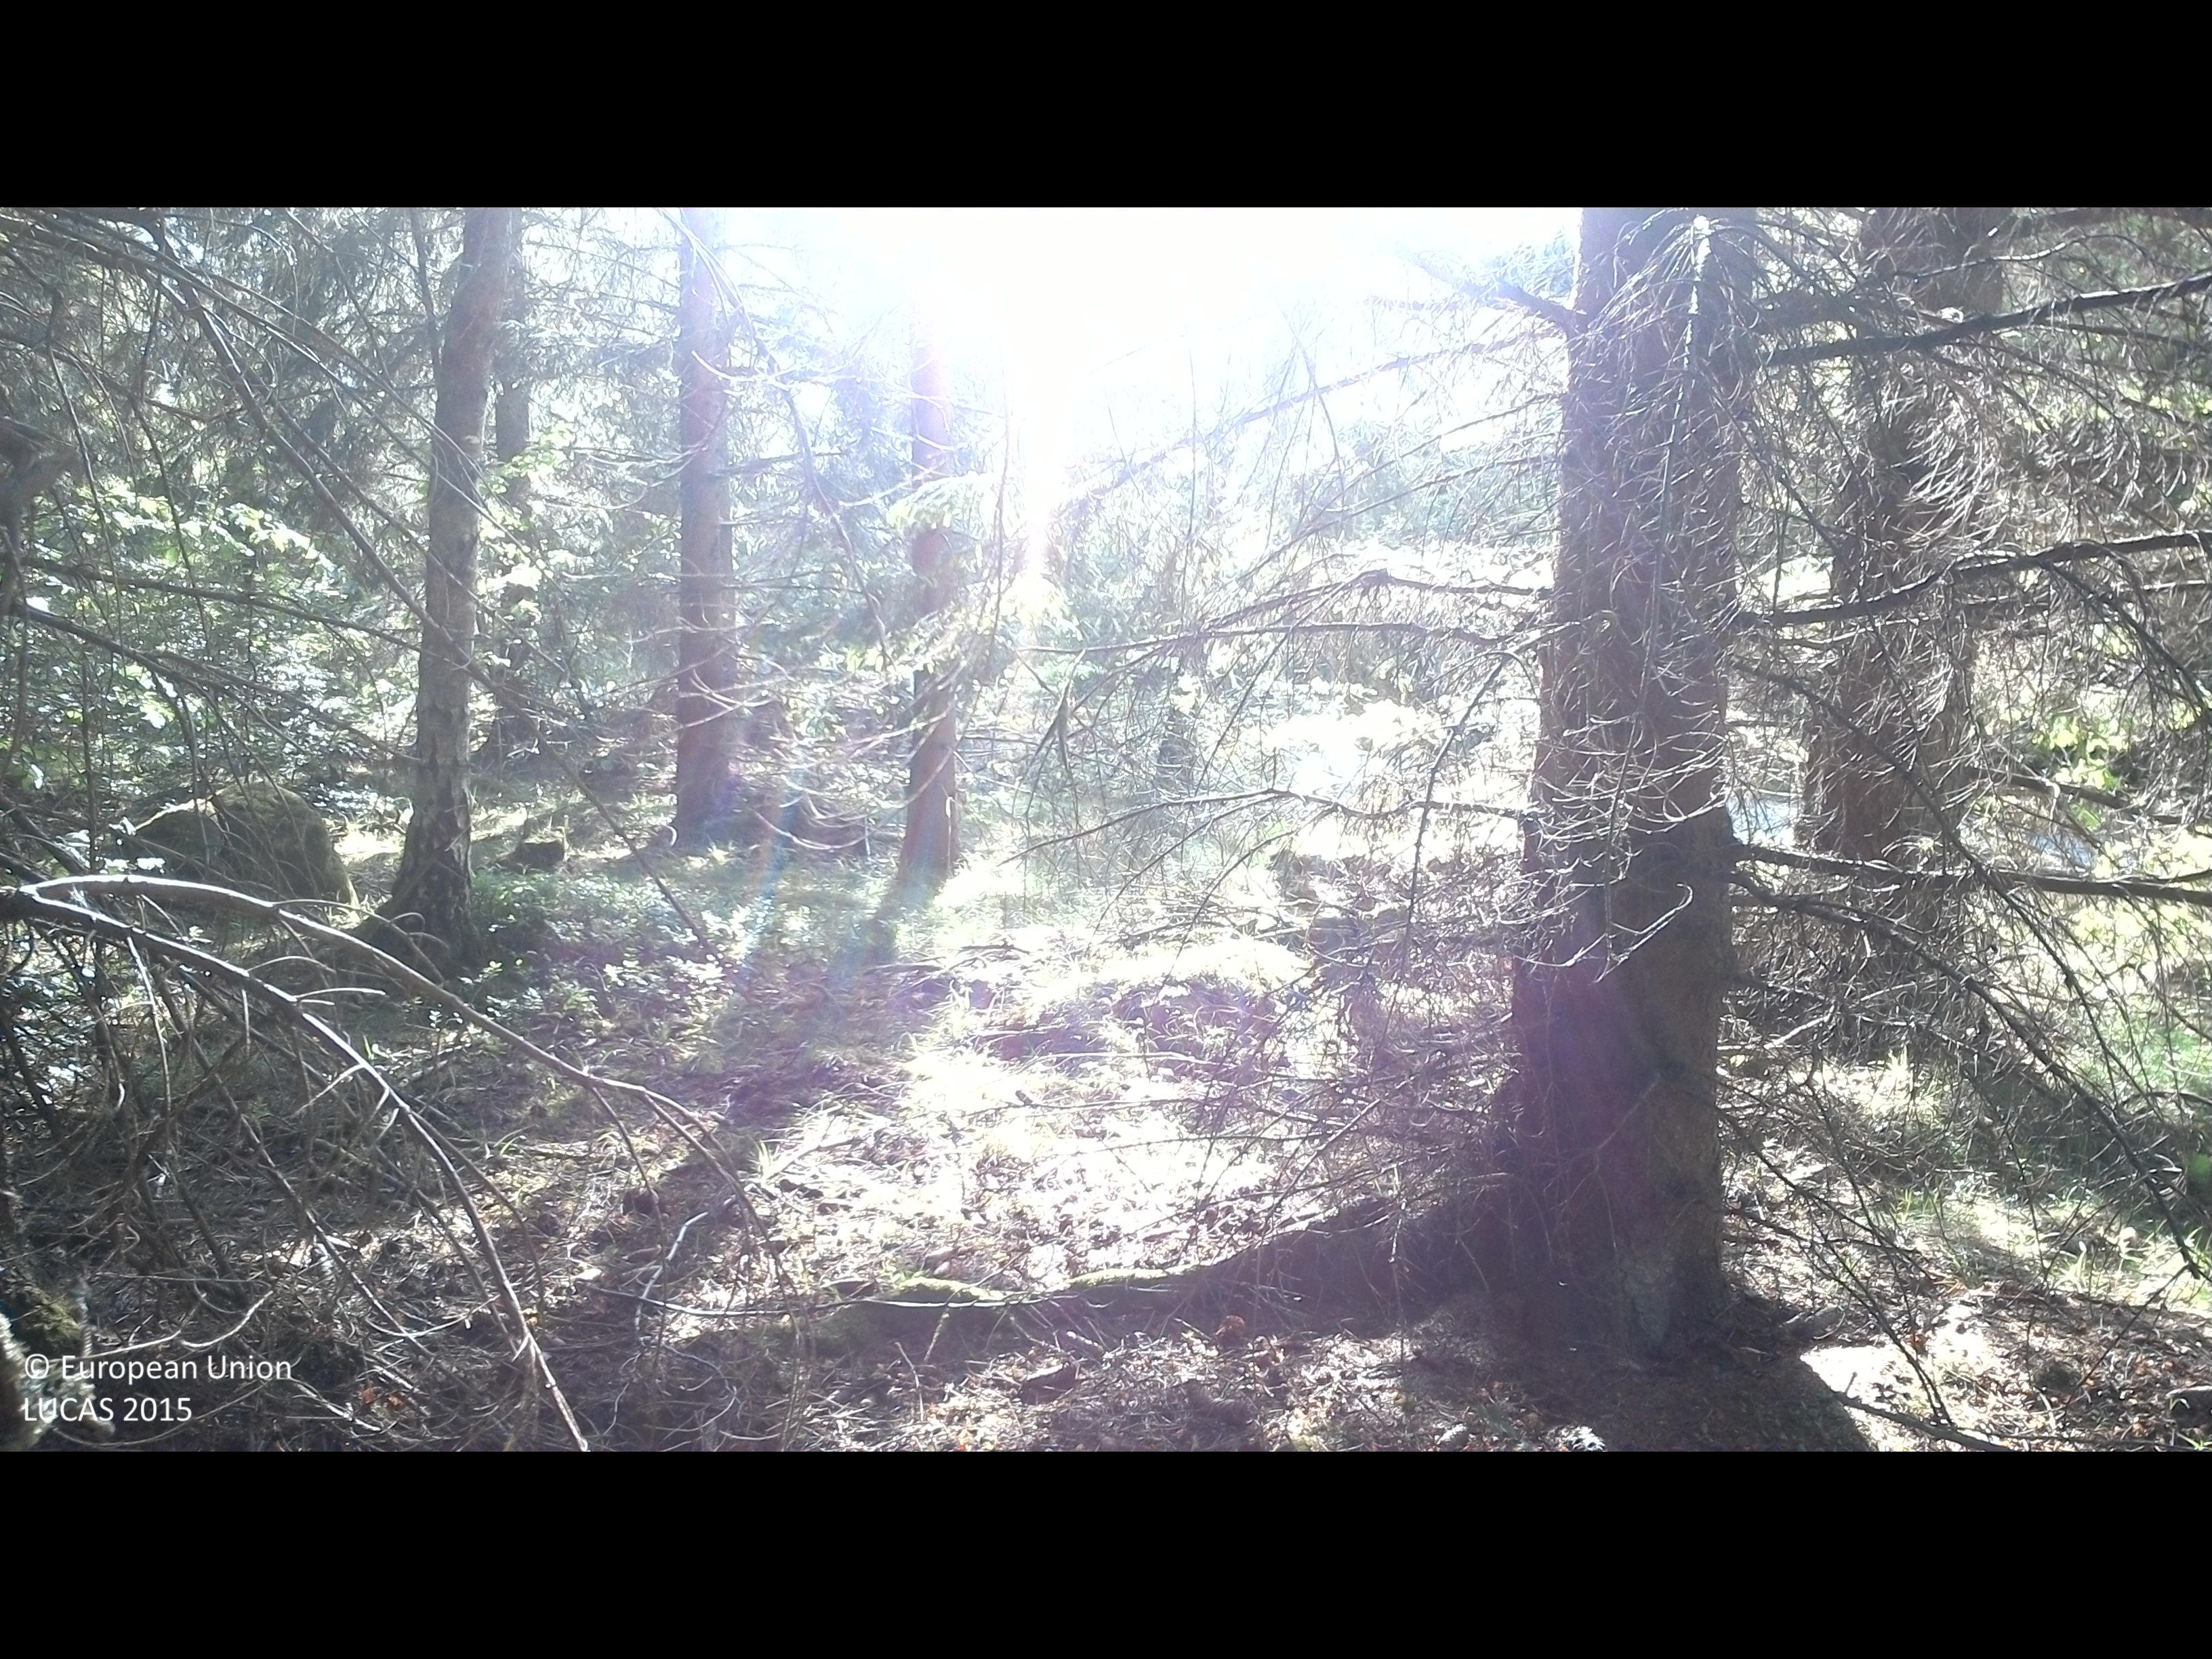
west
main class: Woodland
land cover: Spruce dominated mixed woodland
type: boreal forest
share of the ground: > 75 %
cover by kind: coniferous forest trees 60 %, broadleaved forest trees 20 %, herbaceous plants 20 %
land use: Forestry
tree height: > 5 m
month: June
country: SE
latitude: 56.5955
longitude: 15.8464
